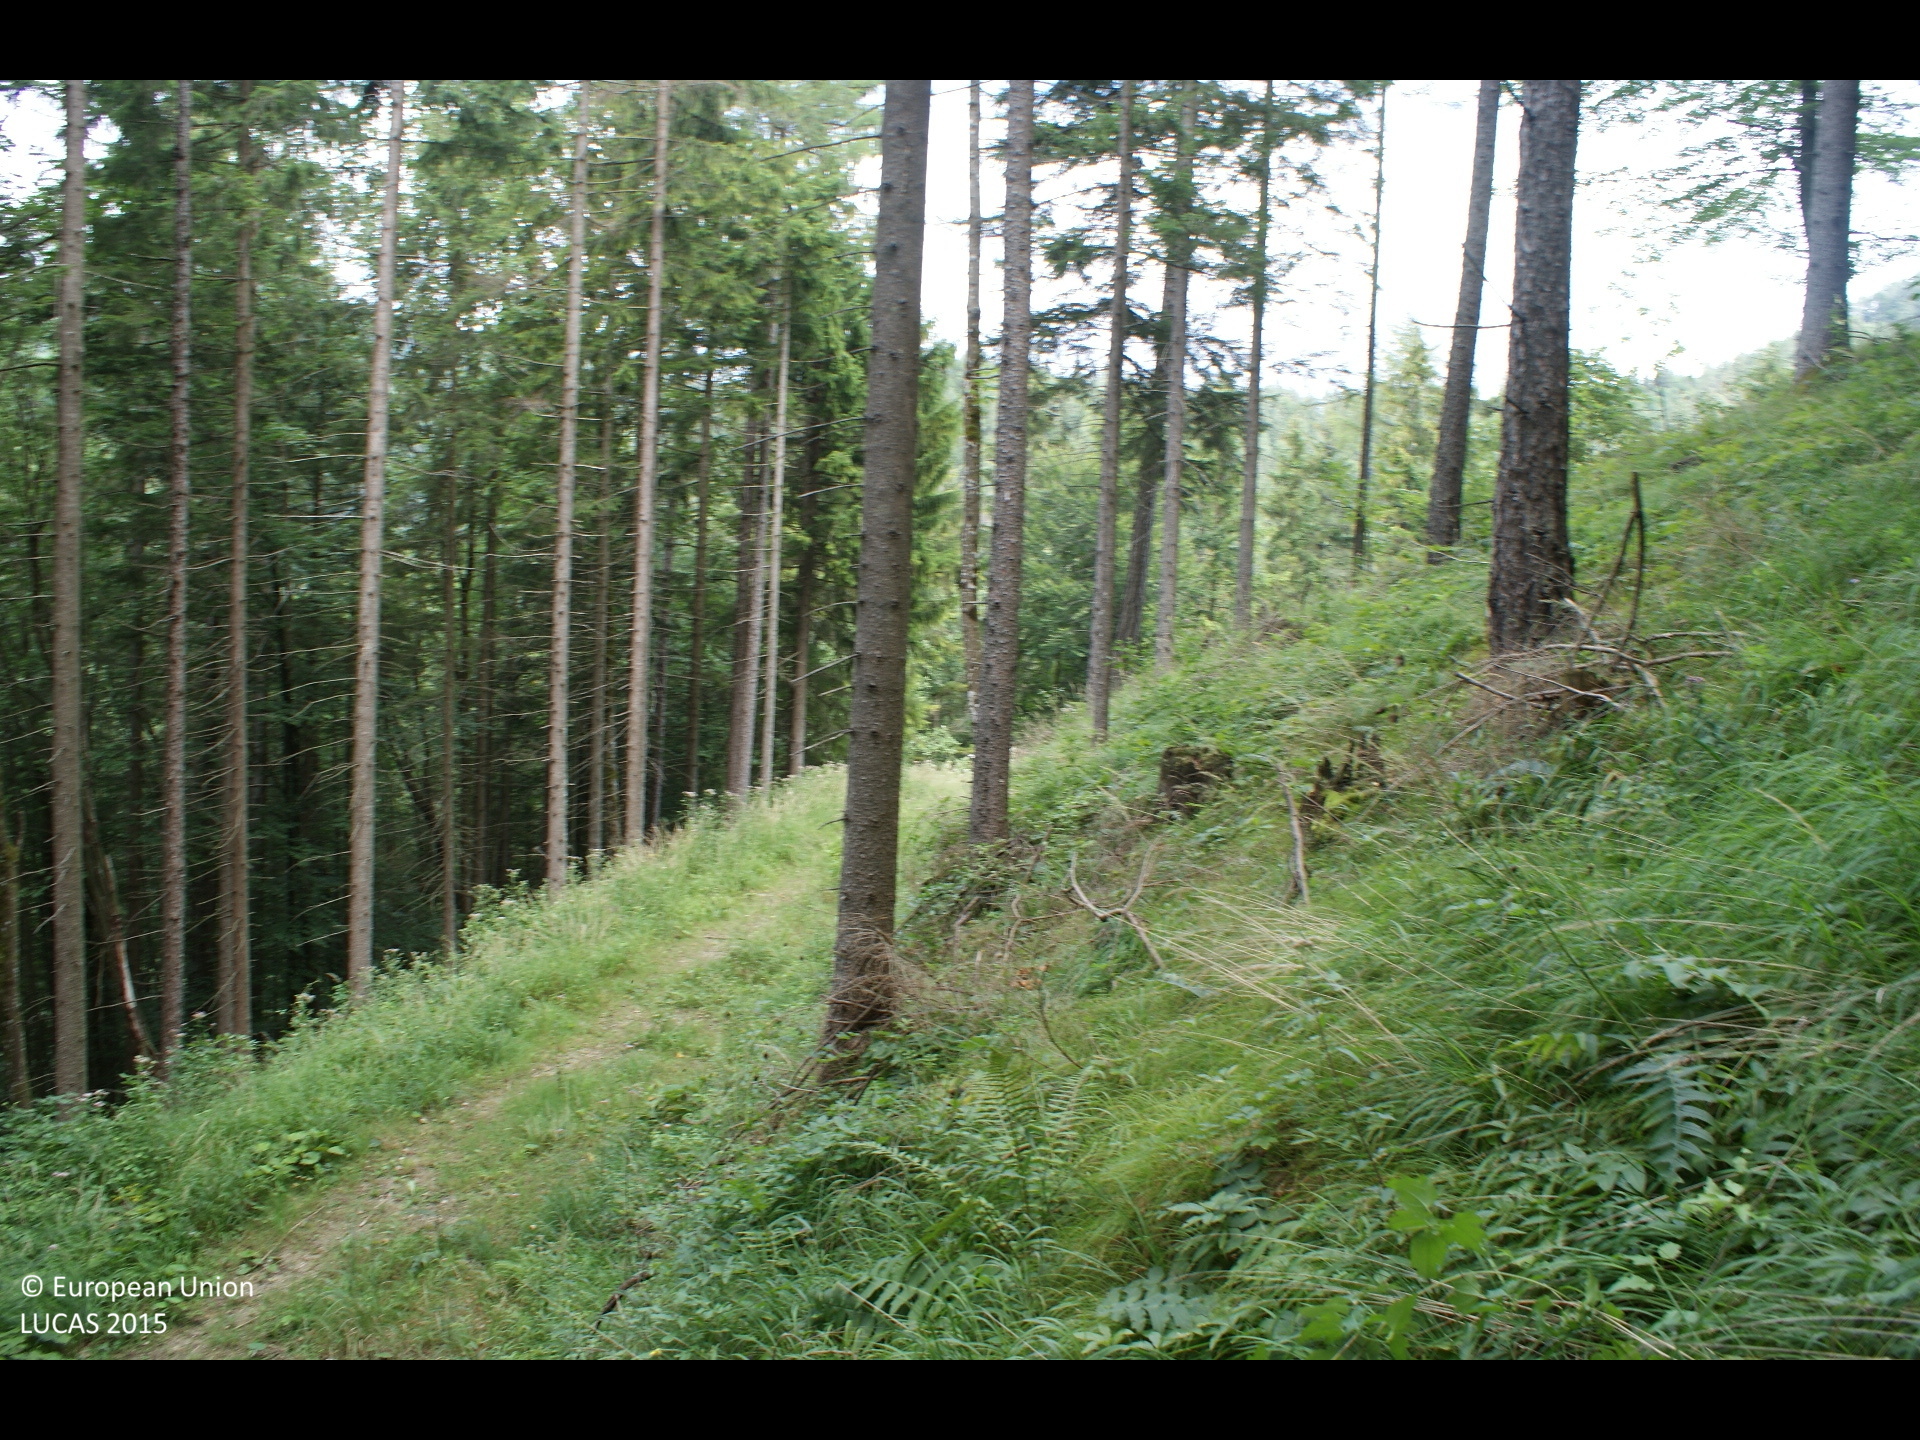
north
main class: Woodland
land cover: Spruce dominated mixed woodland
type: mesophytic deciduous forest
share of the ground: > 75 %
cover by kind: broadleaved forest trees 55 %, coniferous forest trees 25 %, herbaceous plants 15 %, lichens and mosses 5 %
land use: Forestry
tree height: > 5 m
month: July
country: AT
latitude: 47.8428
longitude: 14.9311
